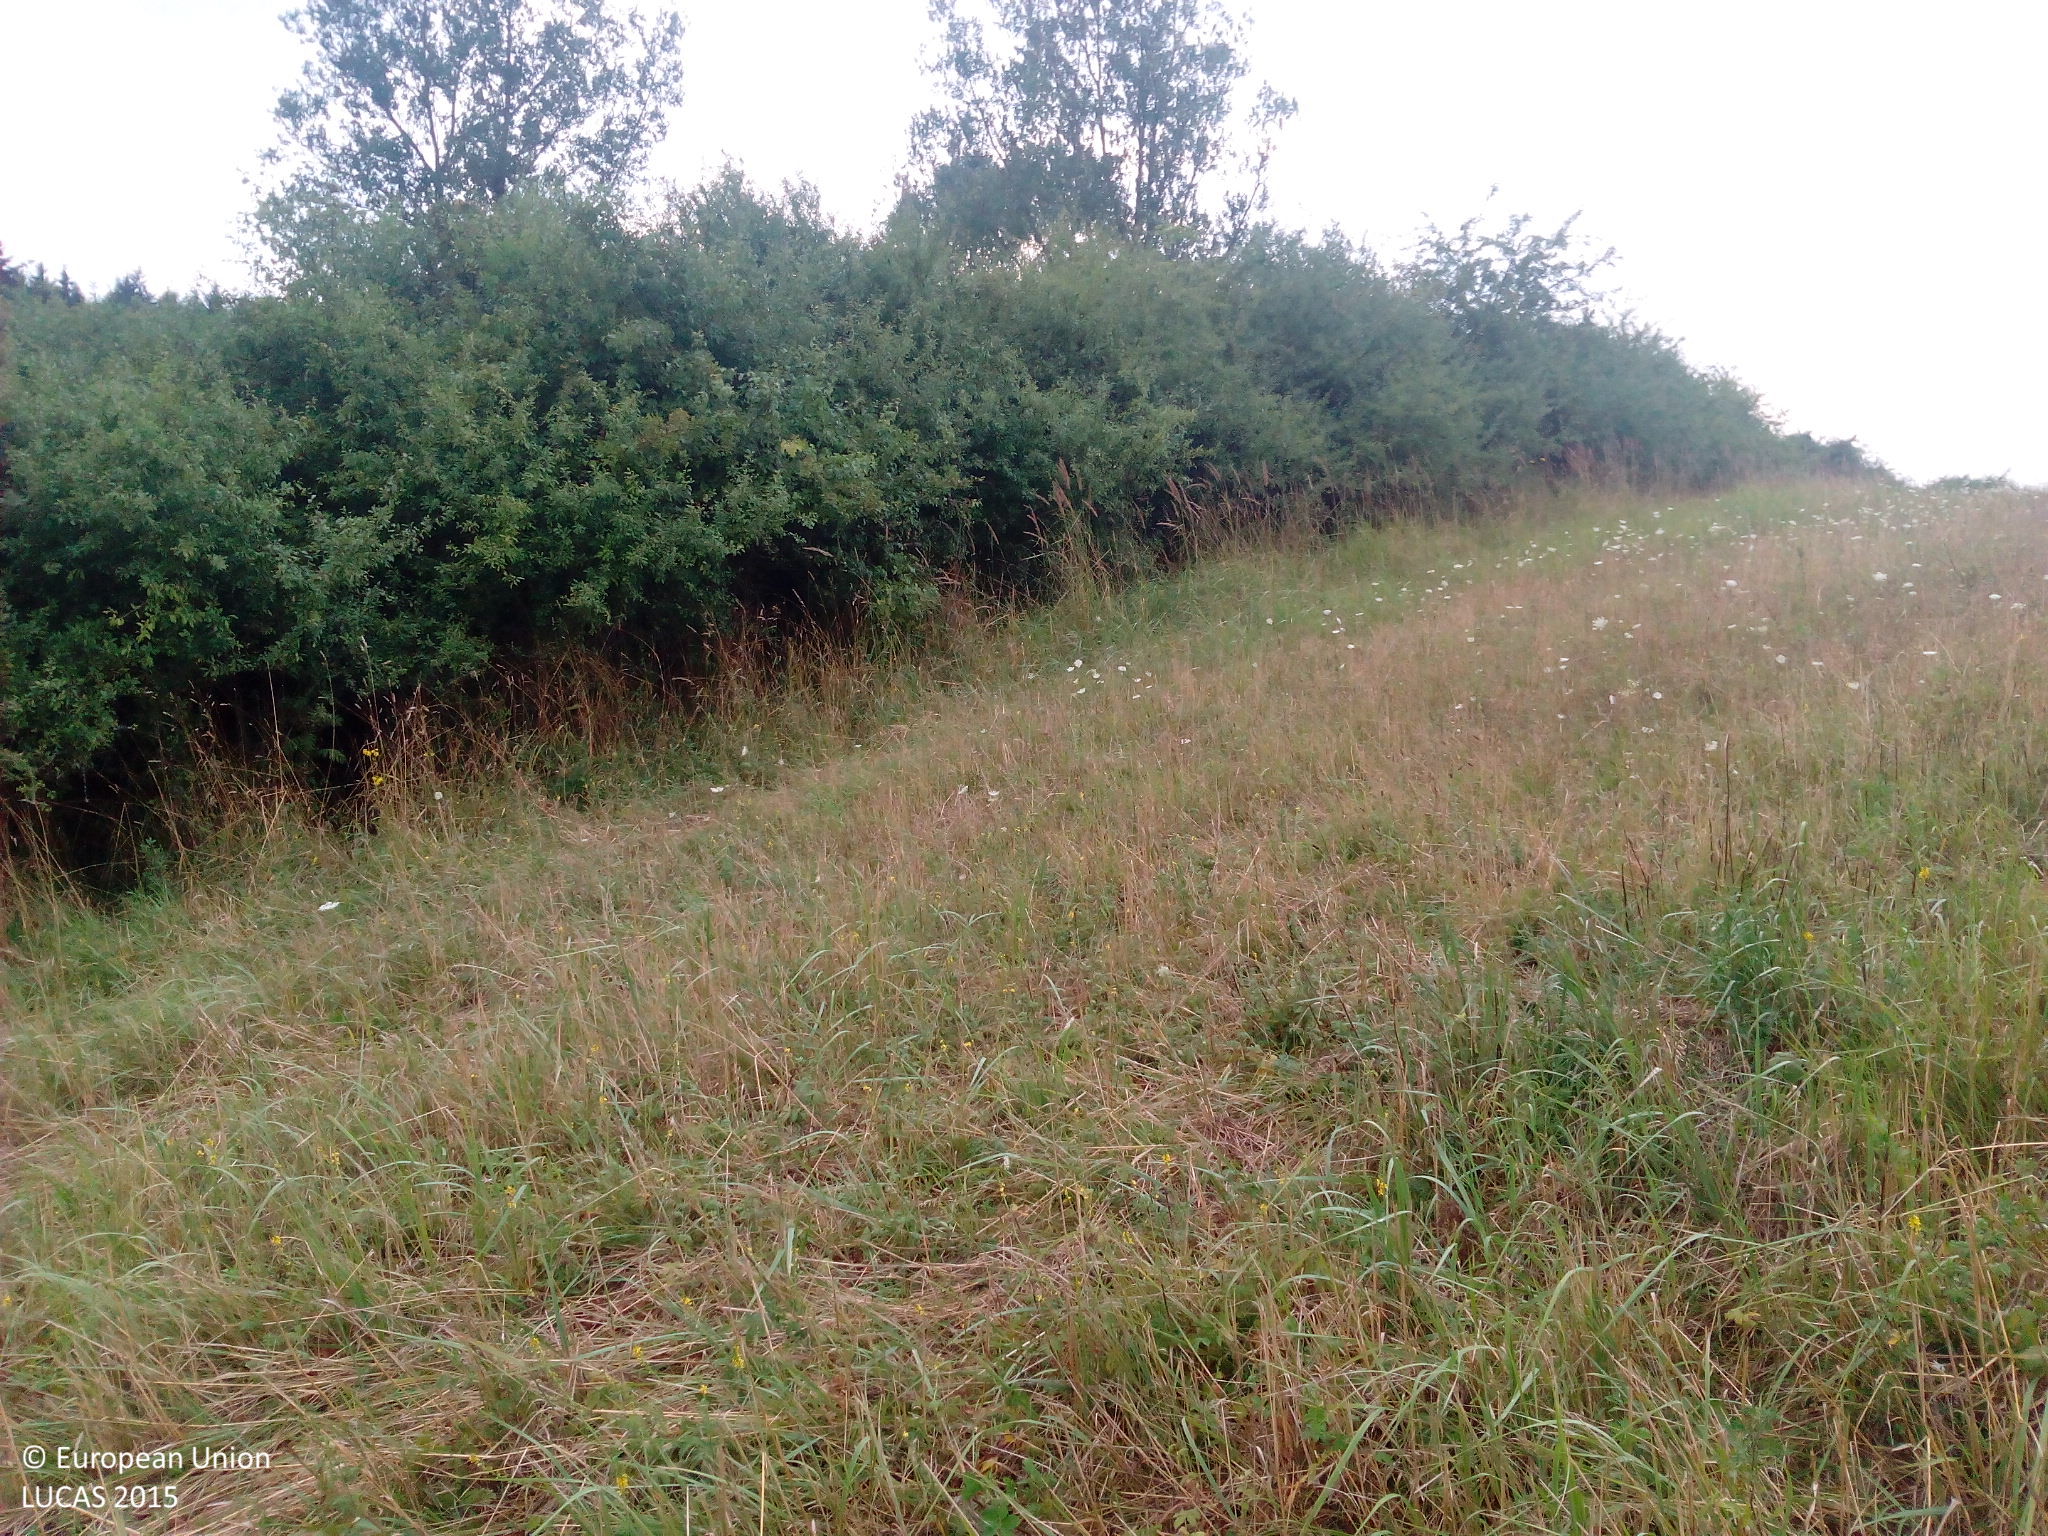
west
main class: Grassland
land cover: Grassland with sparse tree/shrub cover
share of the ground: > 75 %
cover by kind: herbaceous plants 95 %, broadleaved forest trees 5 %
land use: Agriculture (excluding fallow land and kitchen gardens)
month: August
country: DE
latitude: 53.6290
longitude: 13.2204
